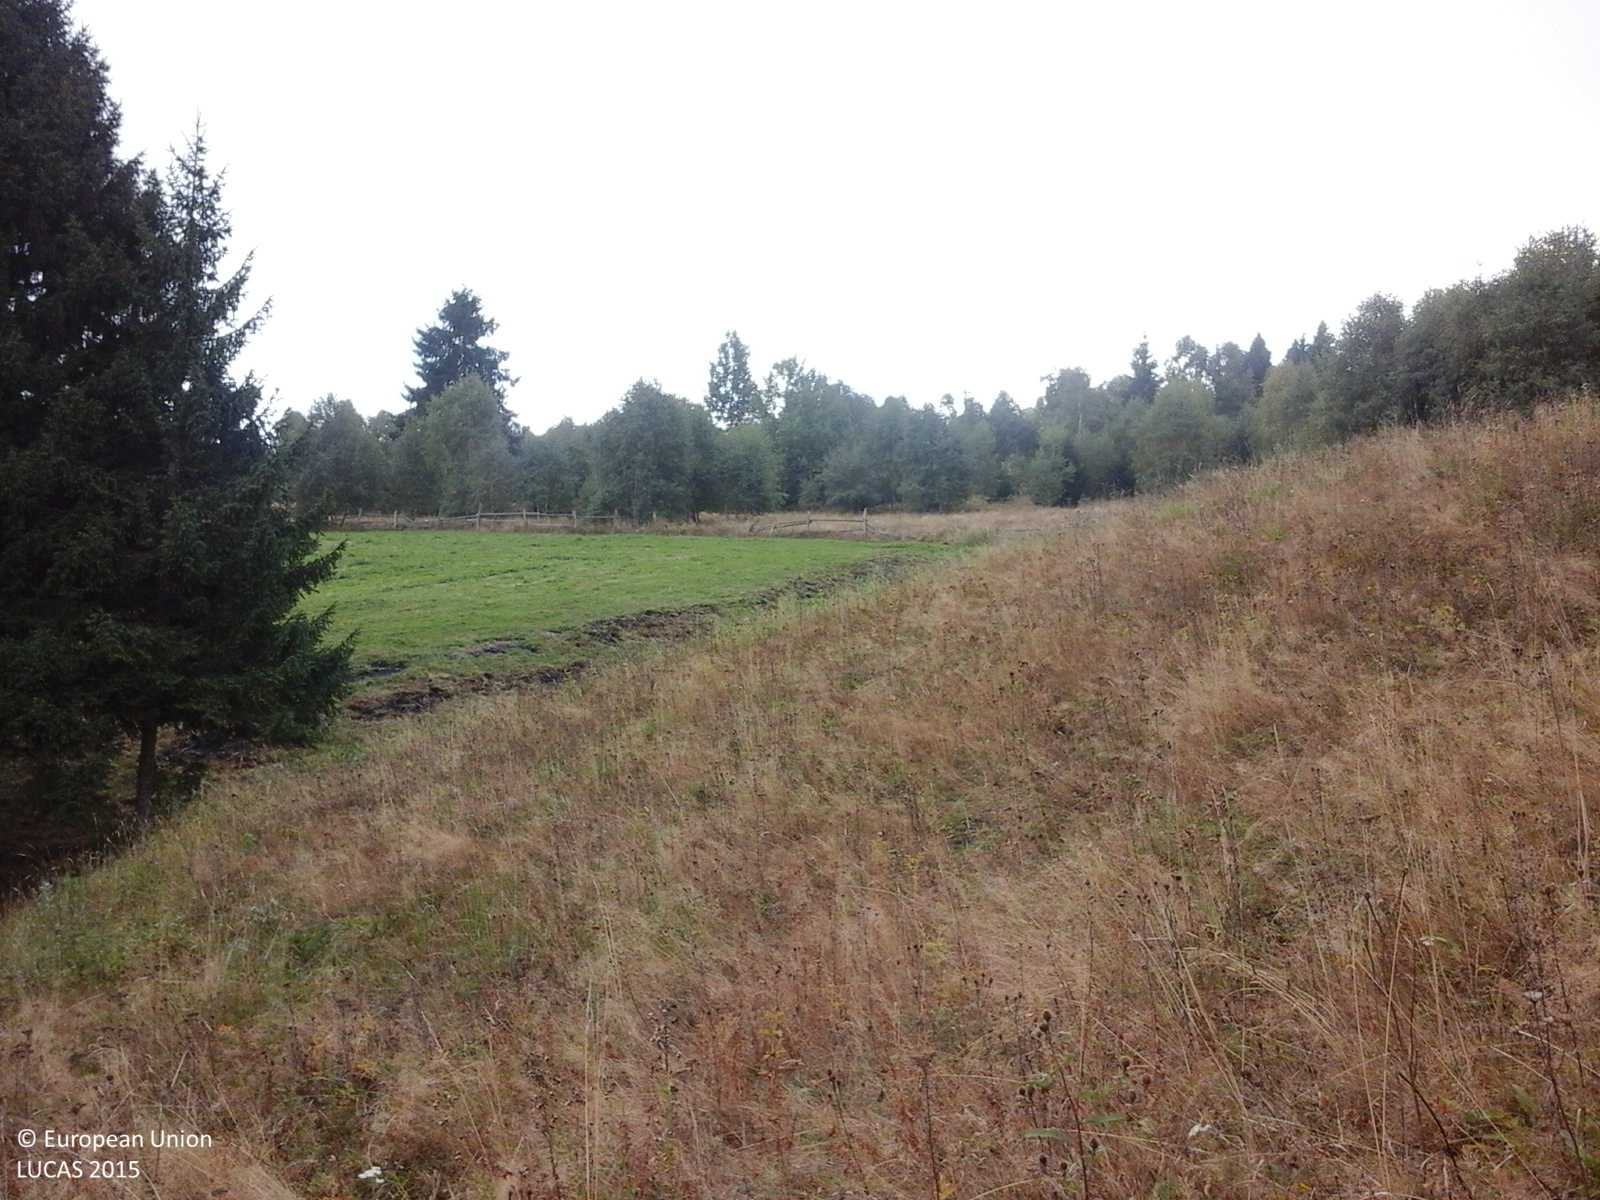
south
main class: Grassland
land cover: Spontaneously vegetated surfaces
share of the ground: > 75 %
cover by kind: herbaceous plants 100 %
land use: Forestry
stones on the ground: < 10 %
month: October
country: RO
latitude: 45.7360
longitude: 23.8586
